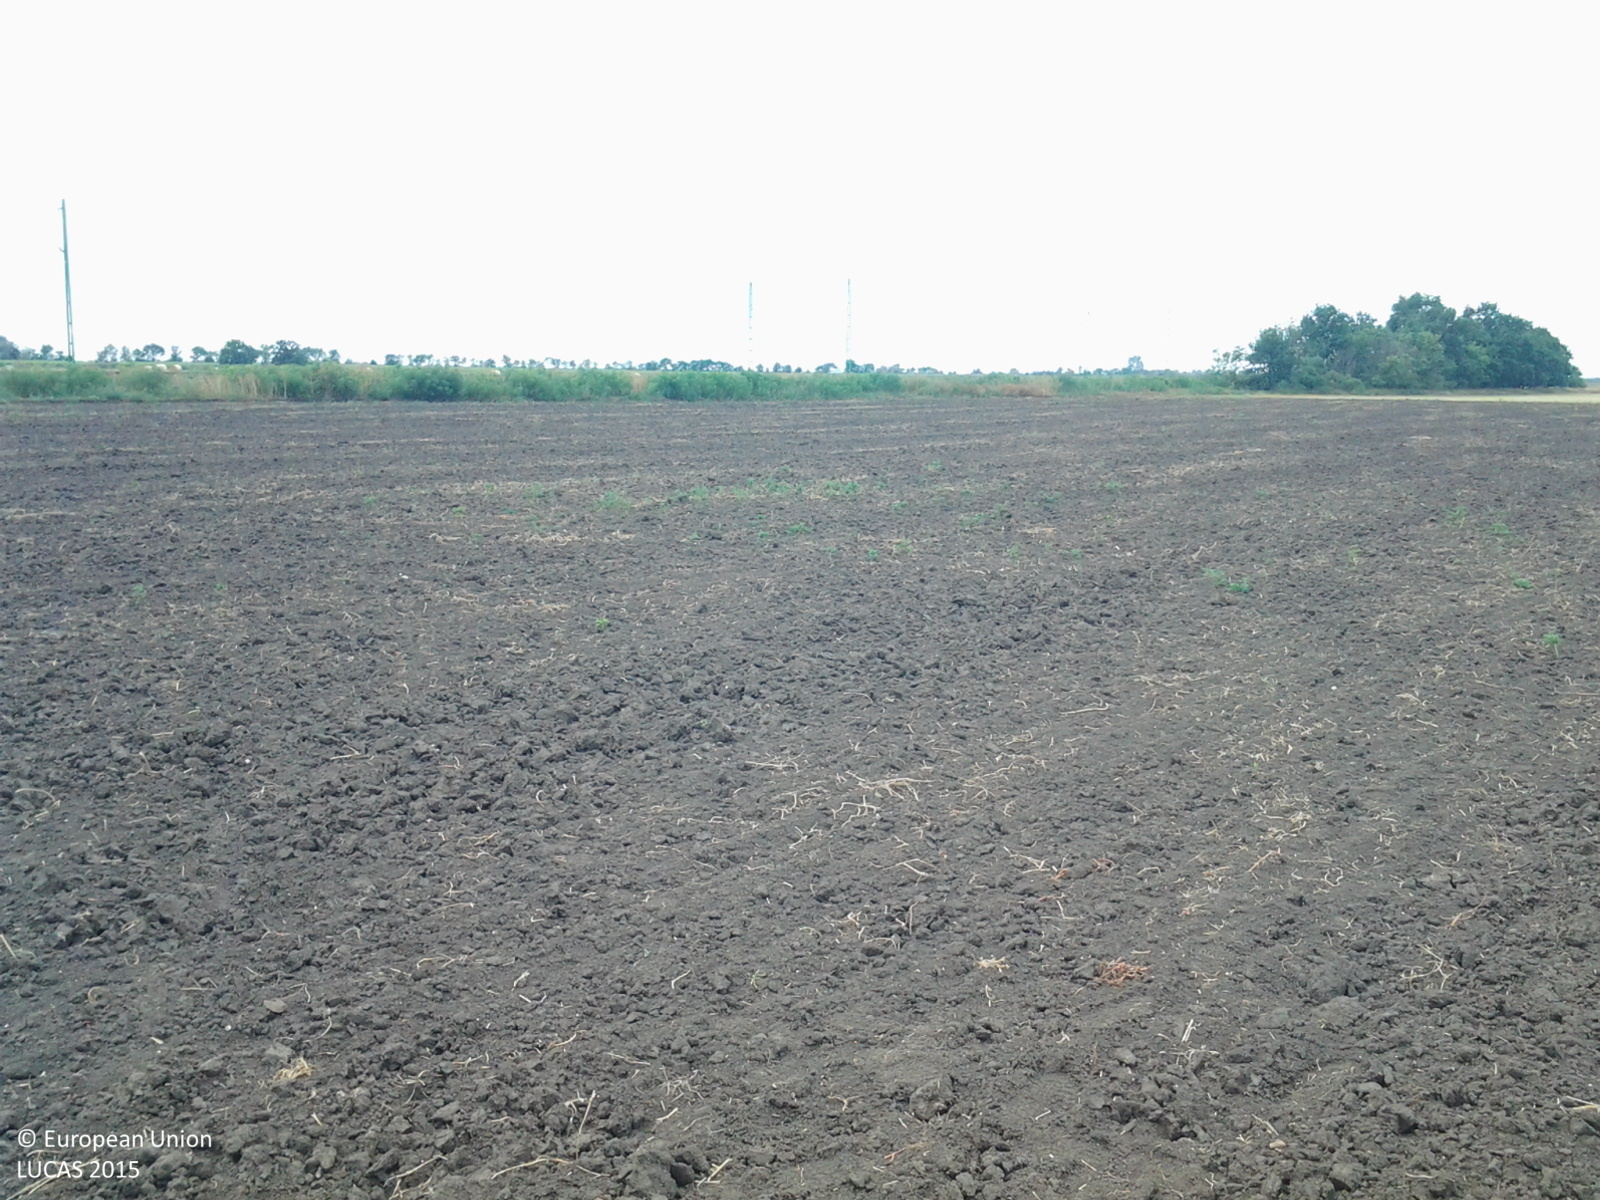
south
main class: Cropland
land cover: Dry pulses
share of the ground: < 10 %
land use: Agriculture (excluding fallow land and kitchen gardens)
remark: Harvested field
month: July
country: HU
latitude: 47.2830
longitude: 20.8888
